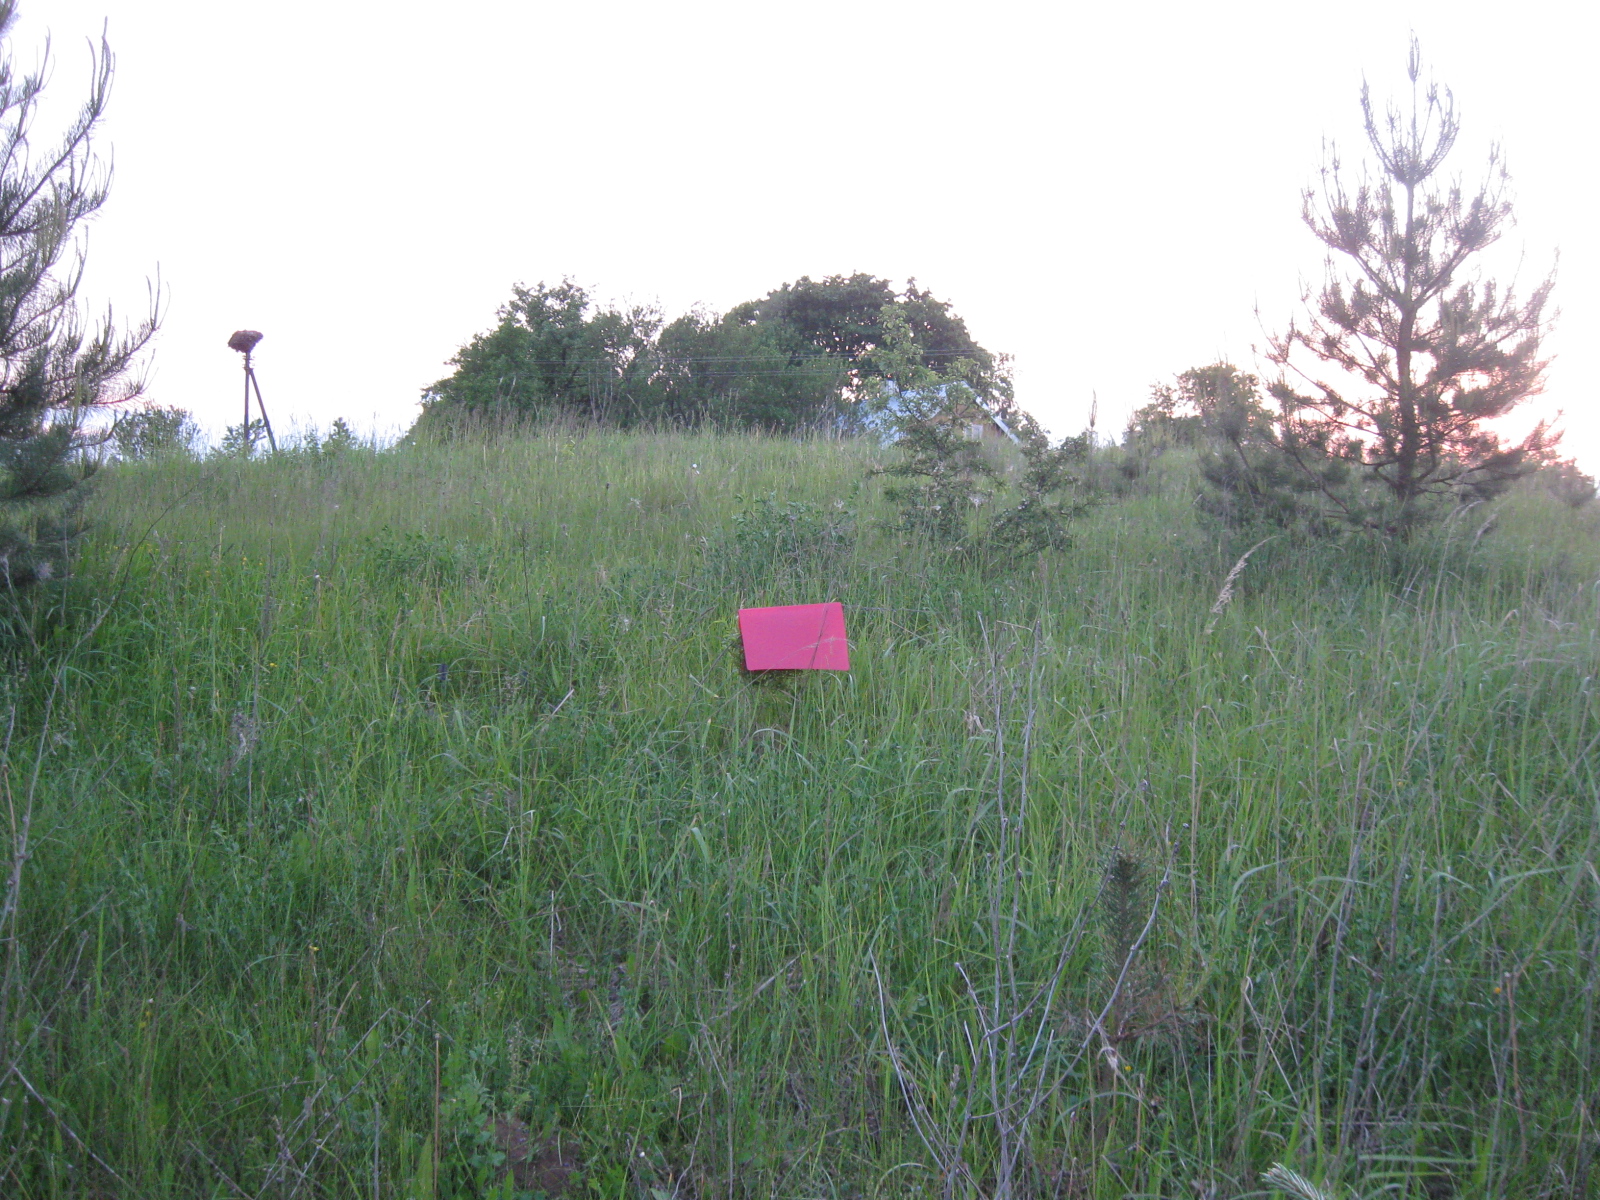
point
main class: Woodland
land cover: Pine dominated coniferous woodland
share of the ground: 25 - 50 %
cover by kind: herbaceous plants 65 %, coniferous forest trees 30 %, broadleaved forest trees 5 %
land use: Agriculture (excluding fallow land and kitchen gardens)
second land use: Forestry
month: June
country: LT
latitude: 54.1978
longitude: 23.7764
